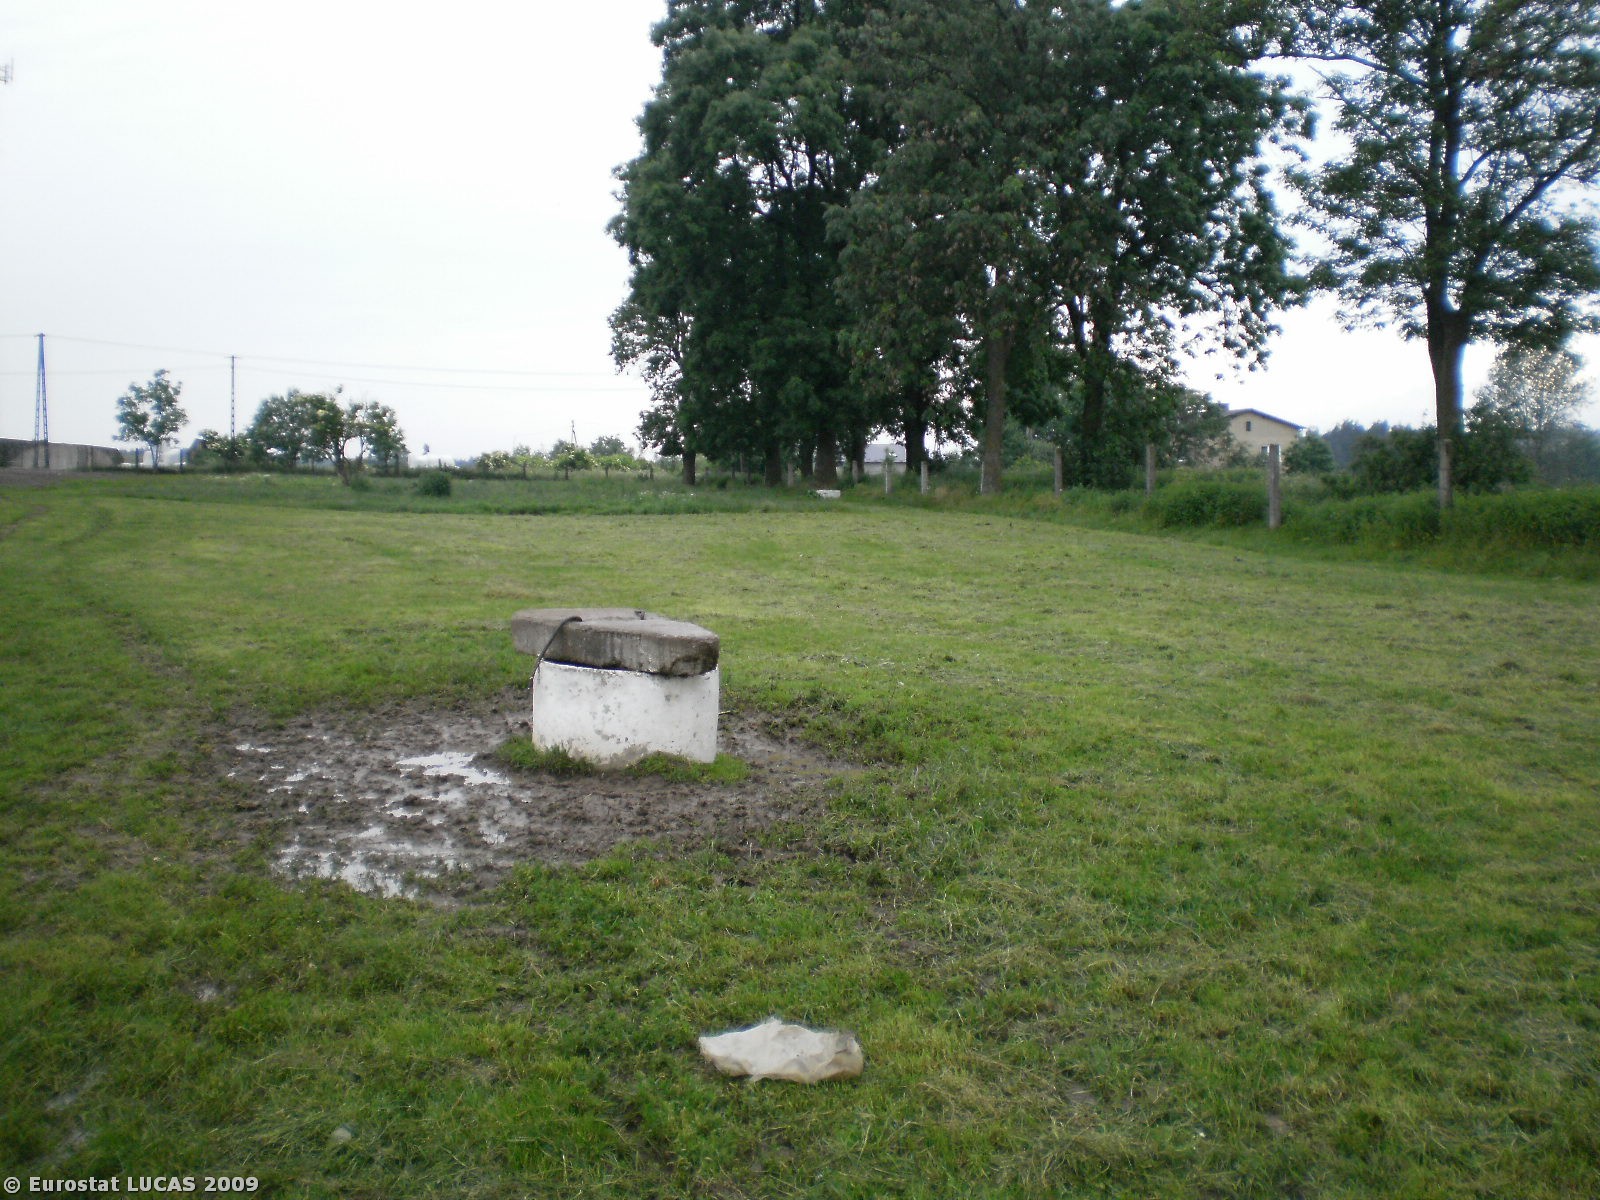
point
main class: Grassland
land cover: Grassland without tree/shrub cover
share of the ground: > 75 %
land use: Agriculture (excluding fallow land and kitchen gardens)
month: June
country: PL
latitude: 53.5984
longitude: 19.8366
